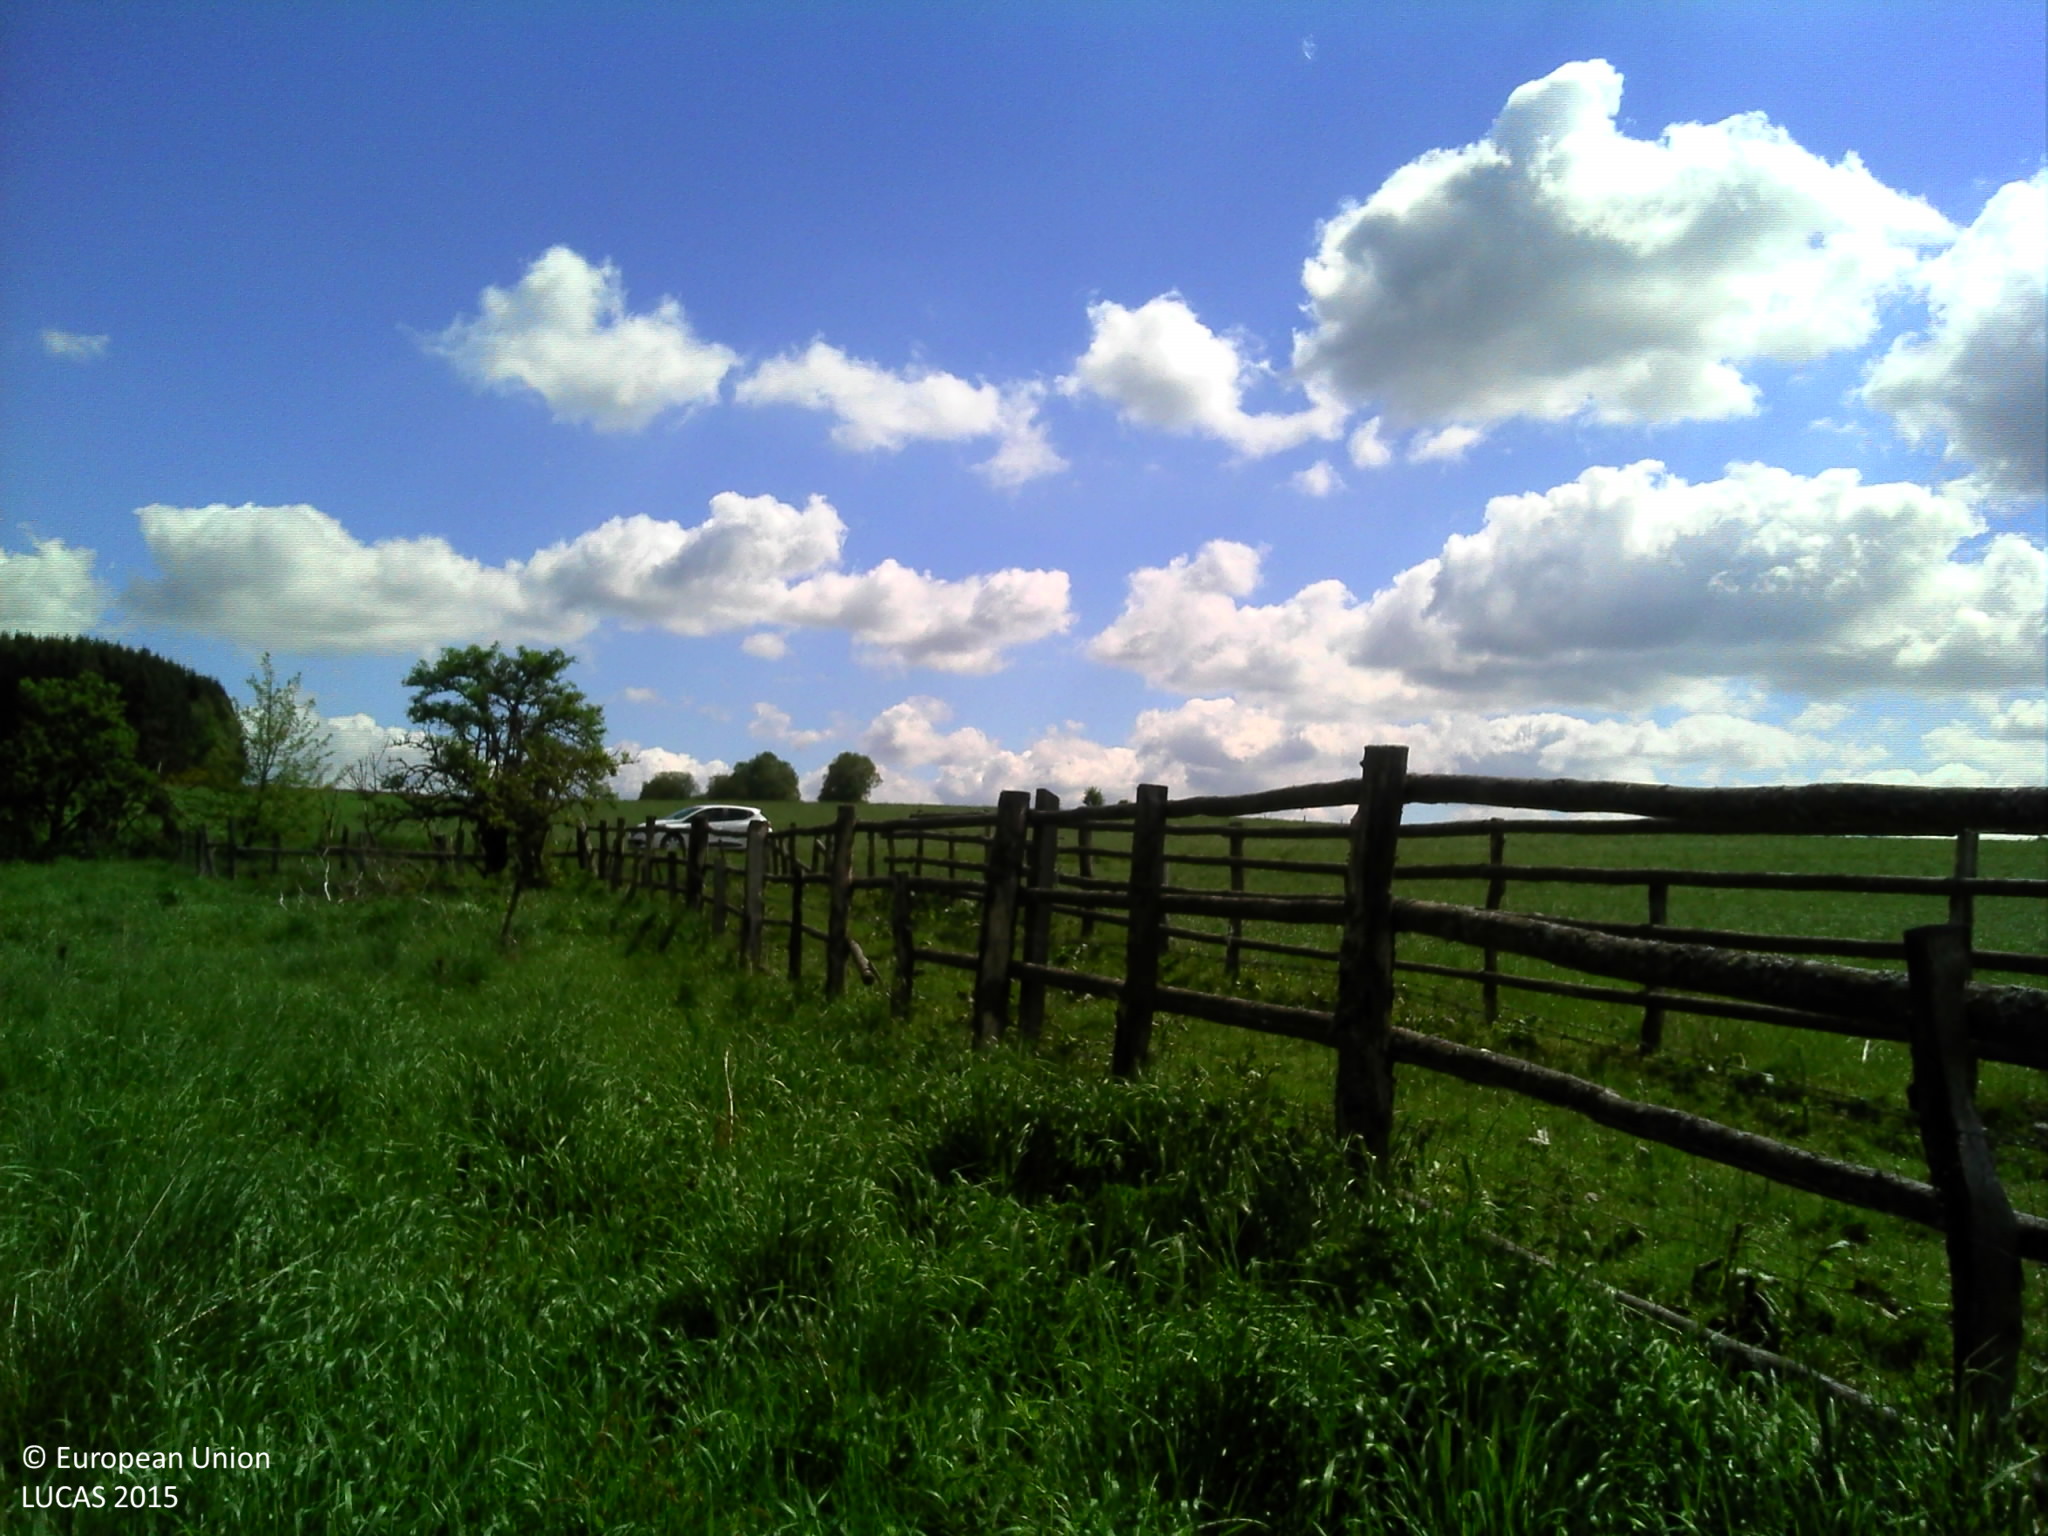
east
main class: Grassland
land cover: Grassland with sparse tree/shrub cover
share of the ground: > 75 %
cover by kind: herbaceous plants 95 %, broadleaved forest trees 5 %
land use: Agriculture (excluding fallow land and kitchen gardens)
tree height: > 5 m
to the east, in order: Grassland with sparse tree/shrub cover; Fences; Grassland without tree/shrub cover; Fences; Other leguminous and mixtures for fodder; Paved roads, cycling and walking lanes; Other leguminous and mixtures for fodder; Paved roads, cycling and walking lanes; Grass margins; Fences; Common wheat
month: May
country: LU
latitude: 50.1675
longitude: 5.9811
